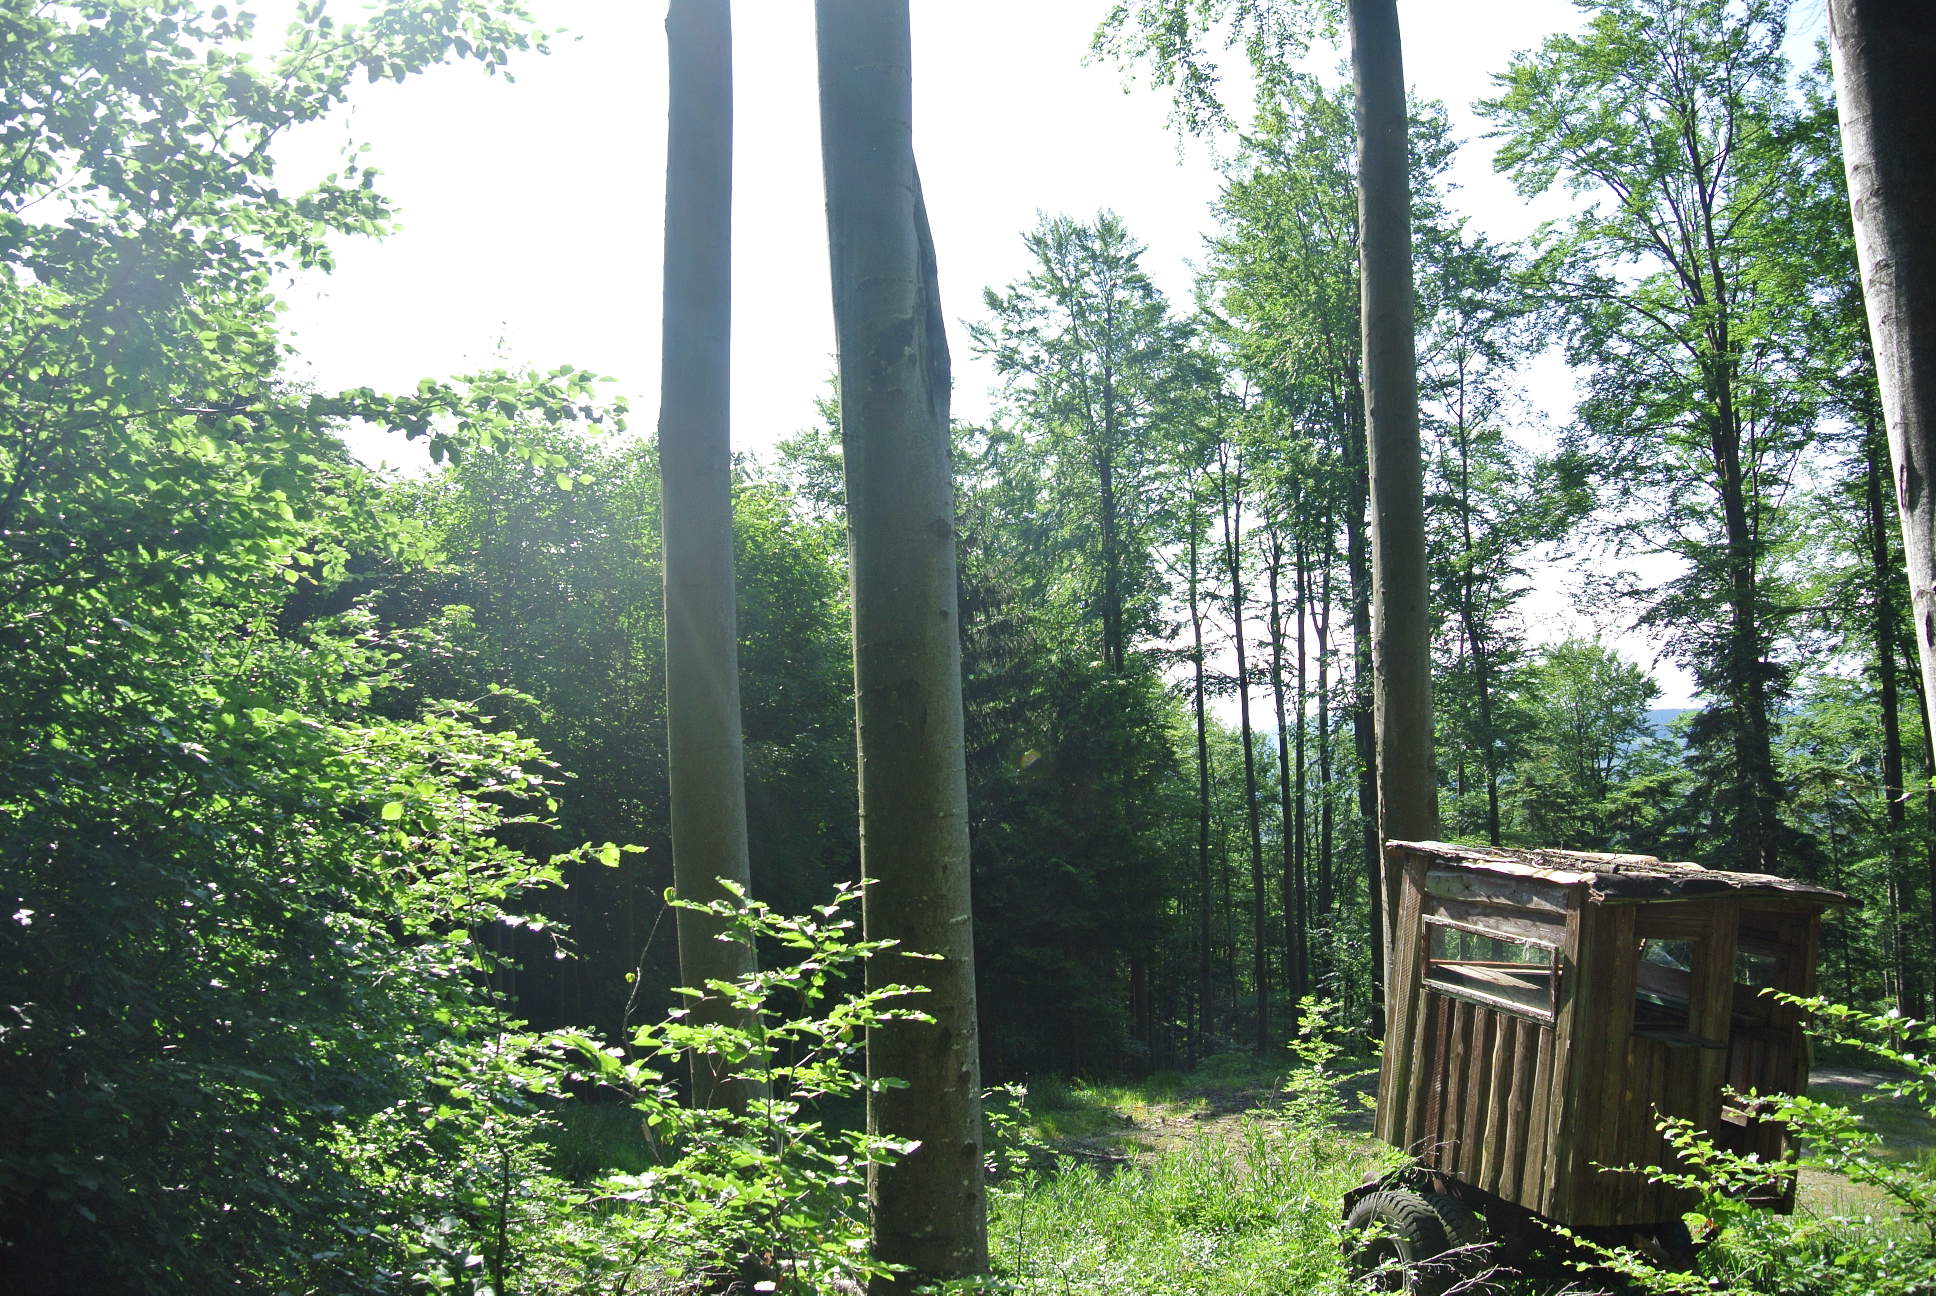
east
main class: Woodland
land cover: Spruce dominated mixed woodland
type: alpine coniferous forest
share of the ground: > 75 %
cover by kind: coniferous forest trees 60 %, broadleaved forest trees 40 %
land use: Forestry
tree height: > 5 m
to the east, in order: Spruce dominated mixed woodland; Grassland without tree/shrub cover; Tracks; Spruce dominated mixed woodland; Spruce dominated coniferous woodland; Spruce dominated mixed woodland; Rivers and streams; Spruce dominated mixed woodland; Broadleaved woodland
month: May
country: AT
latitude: 48.0687
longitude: 15.8408
